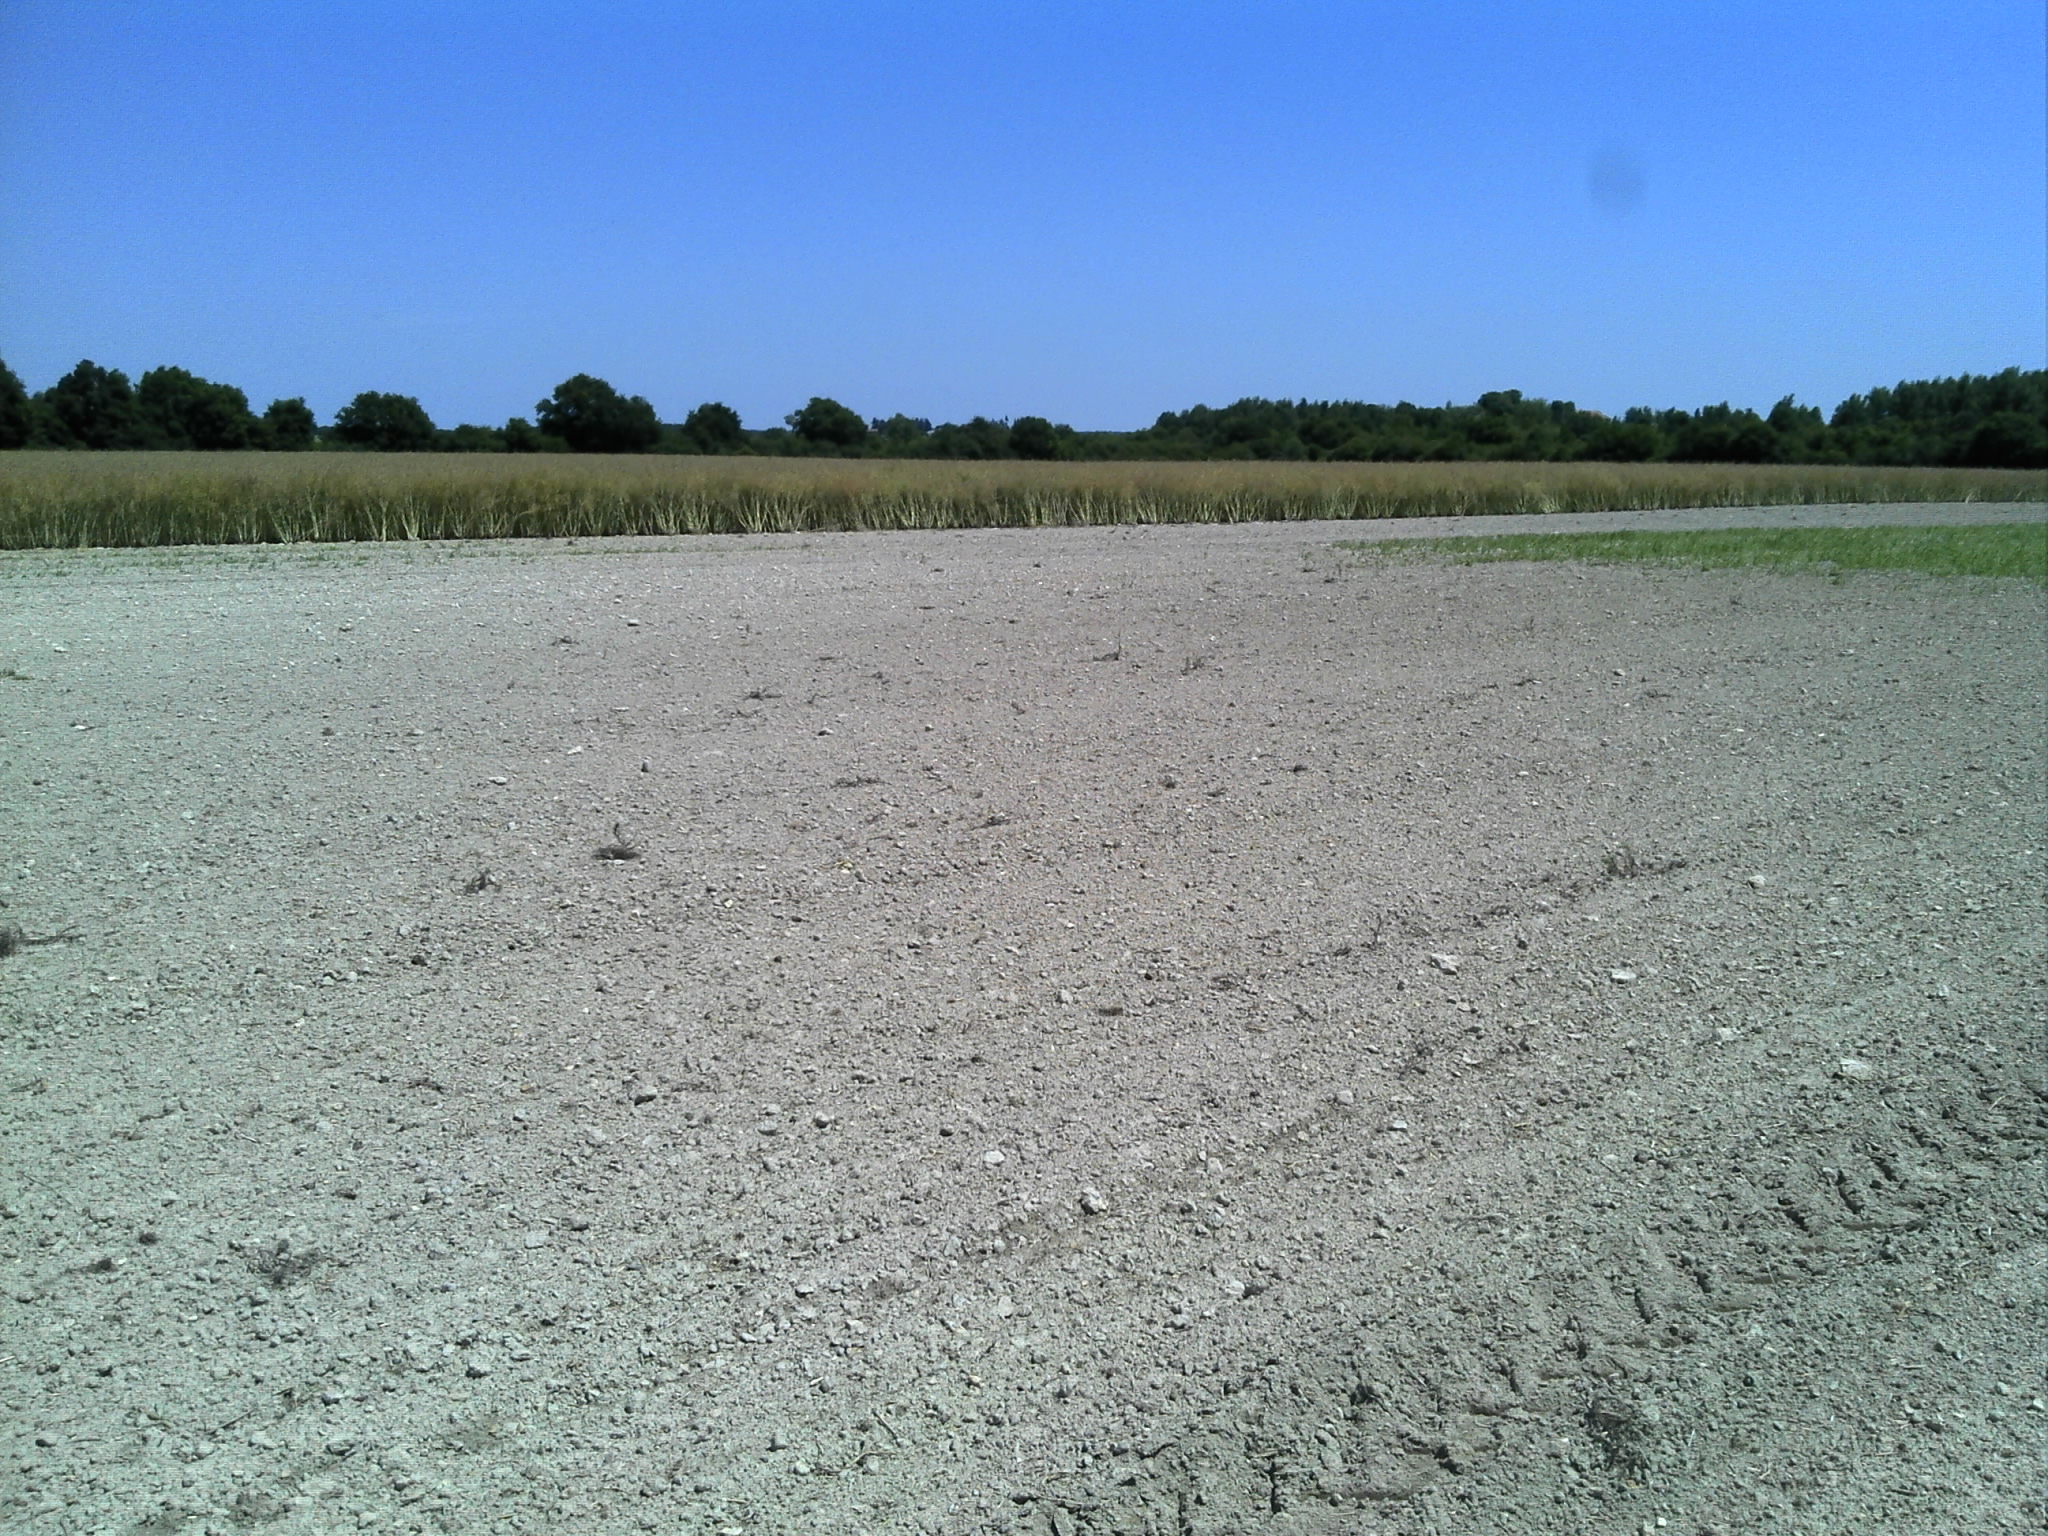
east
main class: Cropland
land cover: Maize
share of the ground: < 10 %
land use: Agriculture (excluding fallow land and kitchen gardens)
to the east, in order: Maize; Rape and turnip rape
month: June
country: FR
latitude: 47.1451
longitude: 1.4021
